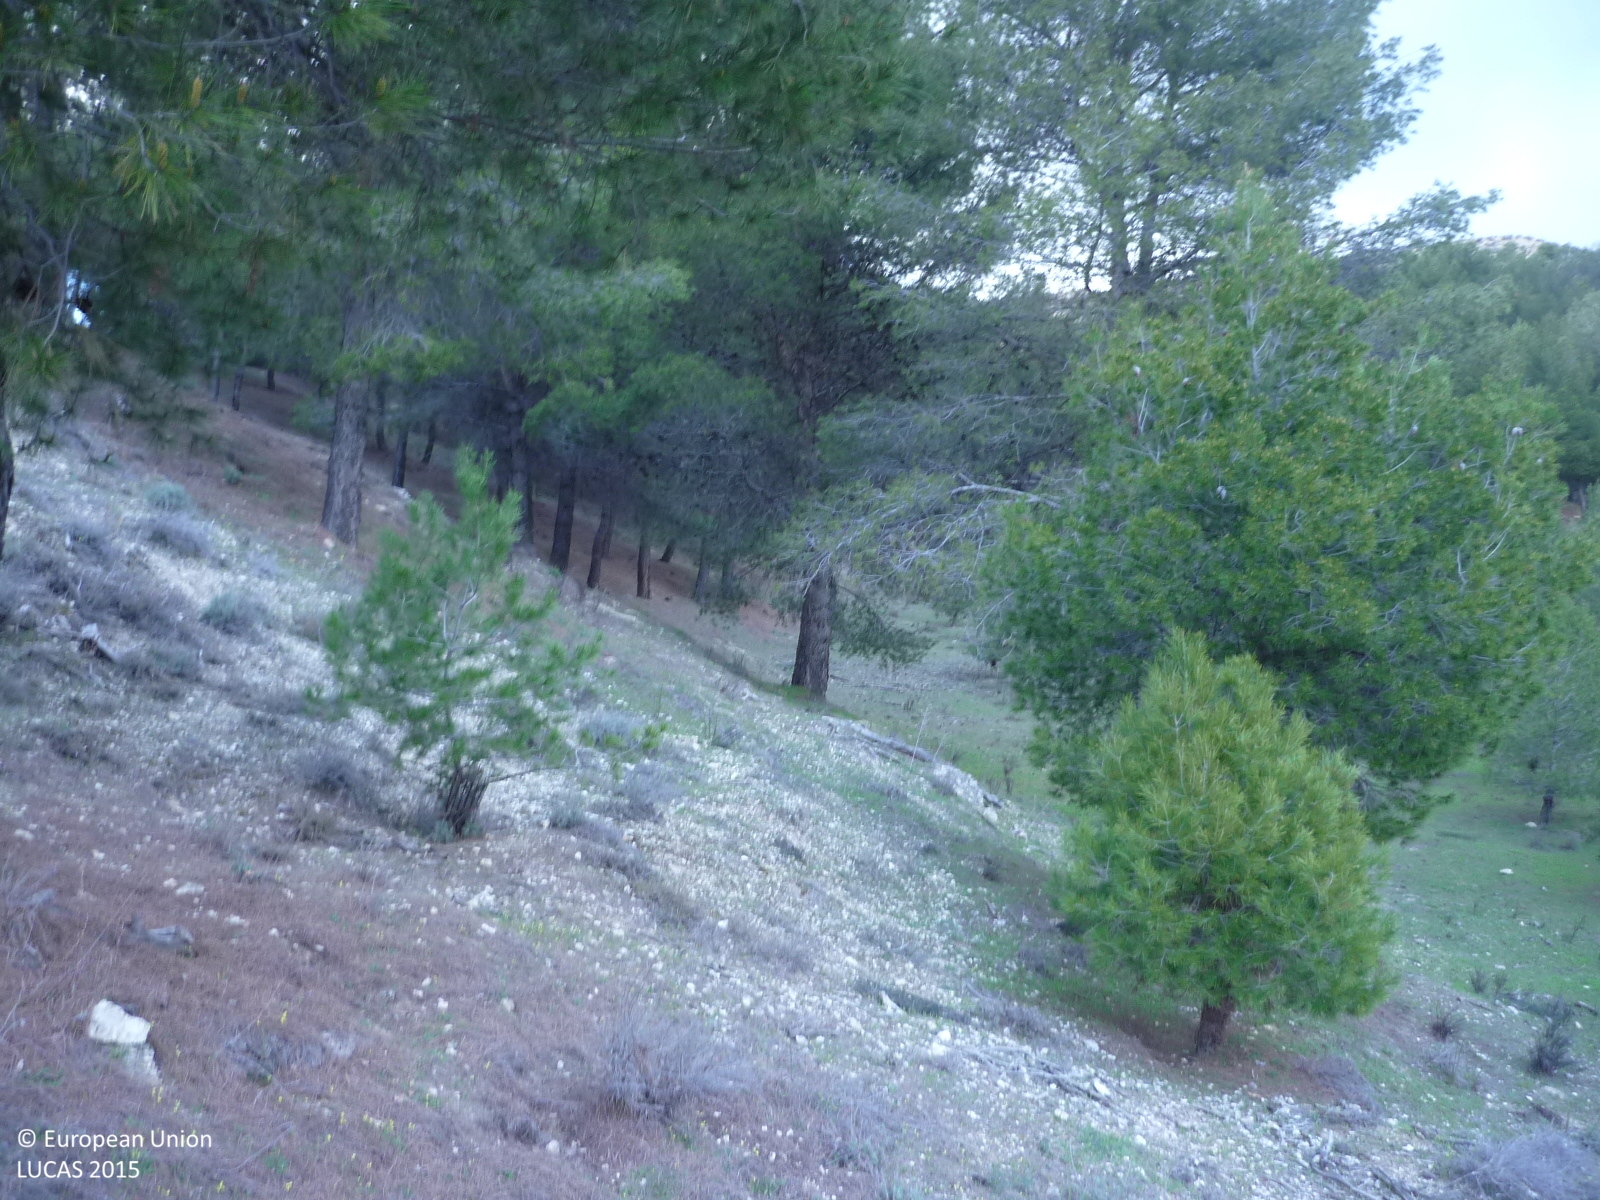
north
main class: Woodland
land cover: Pine dominated coniferous woodland
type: coniferous forest of the mediterranean region
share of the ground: 10 - 25 %
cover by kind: herbaceous plants 45 %, coniferous forest trees 20 %, consolidated bare surface 20 %, shrubs 15 %
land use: Semi-natural and natural areas not in use
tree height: < 5 m
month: March
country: ES
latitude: 40.4805
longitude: -3.5192
